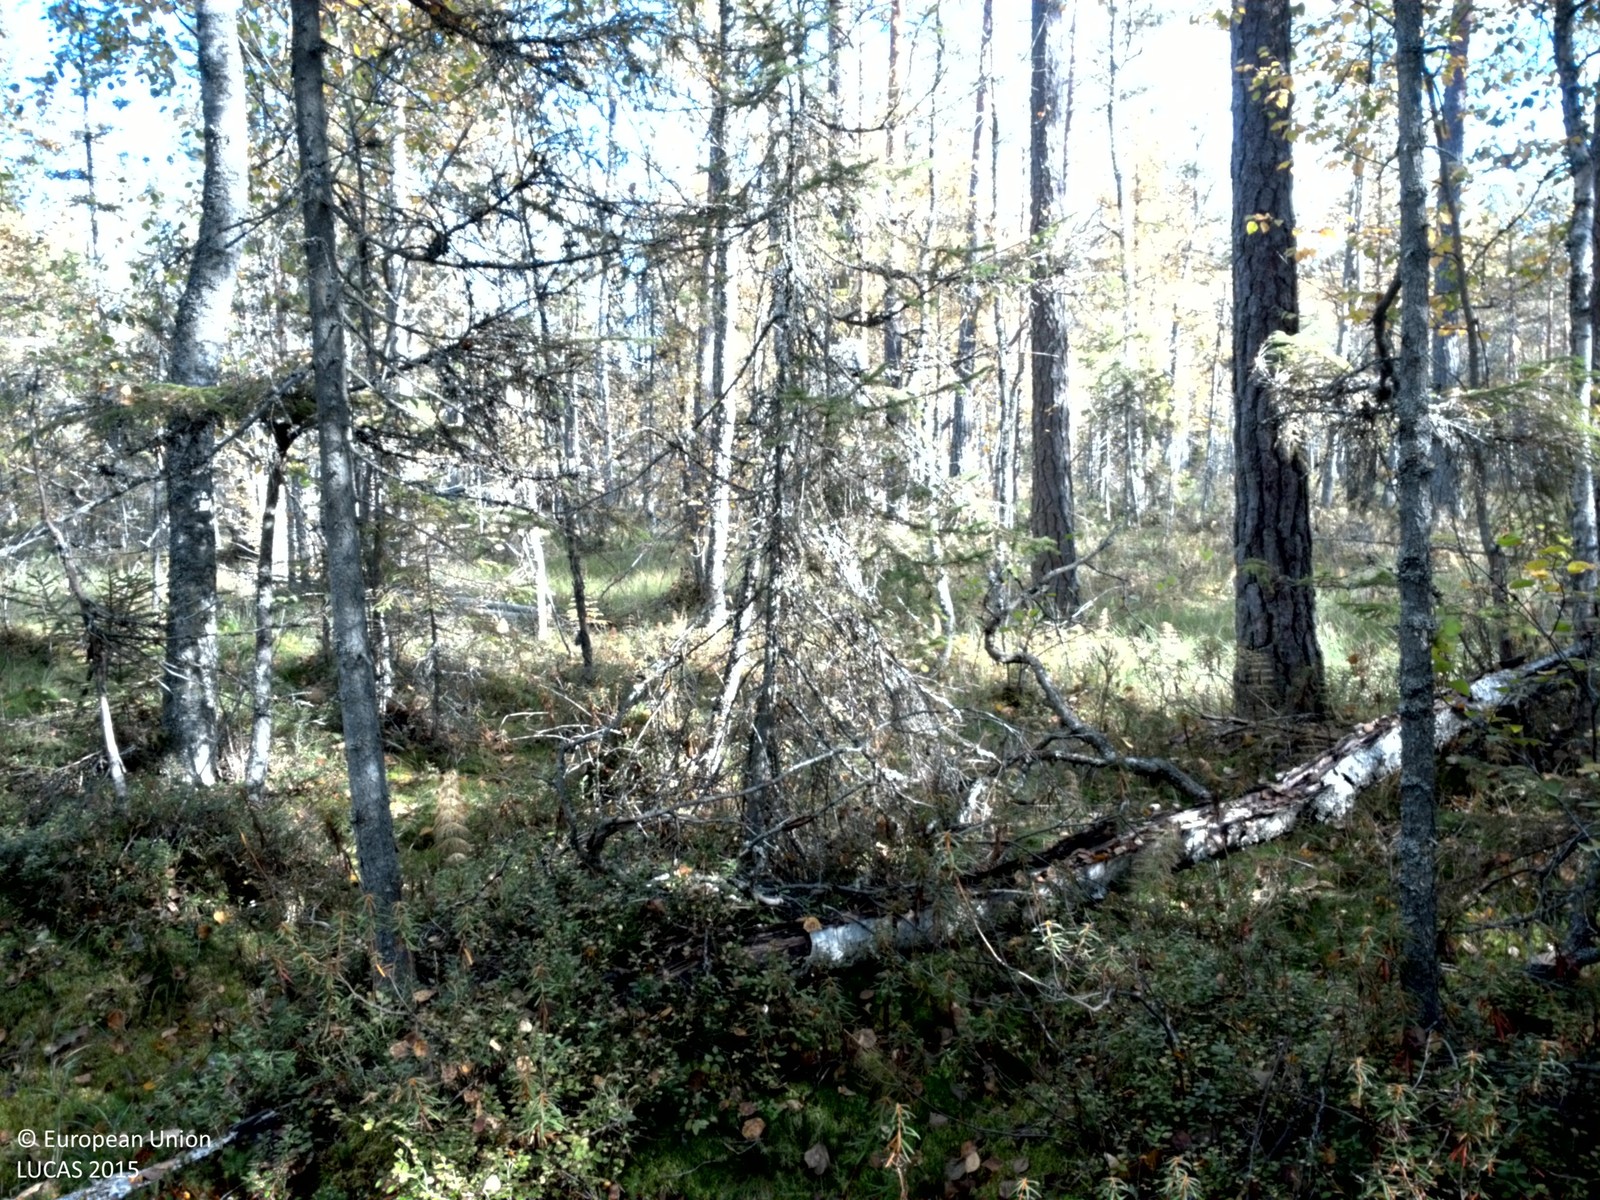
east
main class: Woodland
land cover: Spruce dominated mixed woodland
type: mire and swamp forests
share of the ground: 50 - 75 %
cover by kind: coniferous forest trees 45 %, lichens and mosses 40 %, broadleaved forest trees 15 %
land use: Forestry
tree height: > 5 m
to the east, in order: Spruce dominated mixed woodland; Pine dominated mixed woodland; Spruce dominated mixed woodland; Spruce dominated coniferous woodland
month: September
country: SE
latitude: 60.1381
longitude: 16.5260
